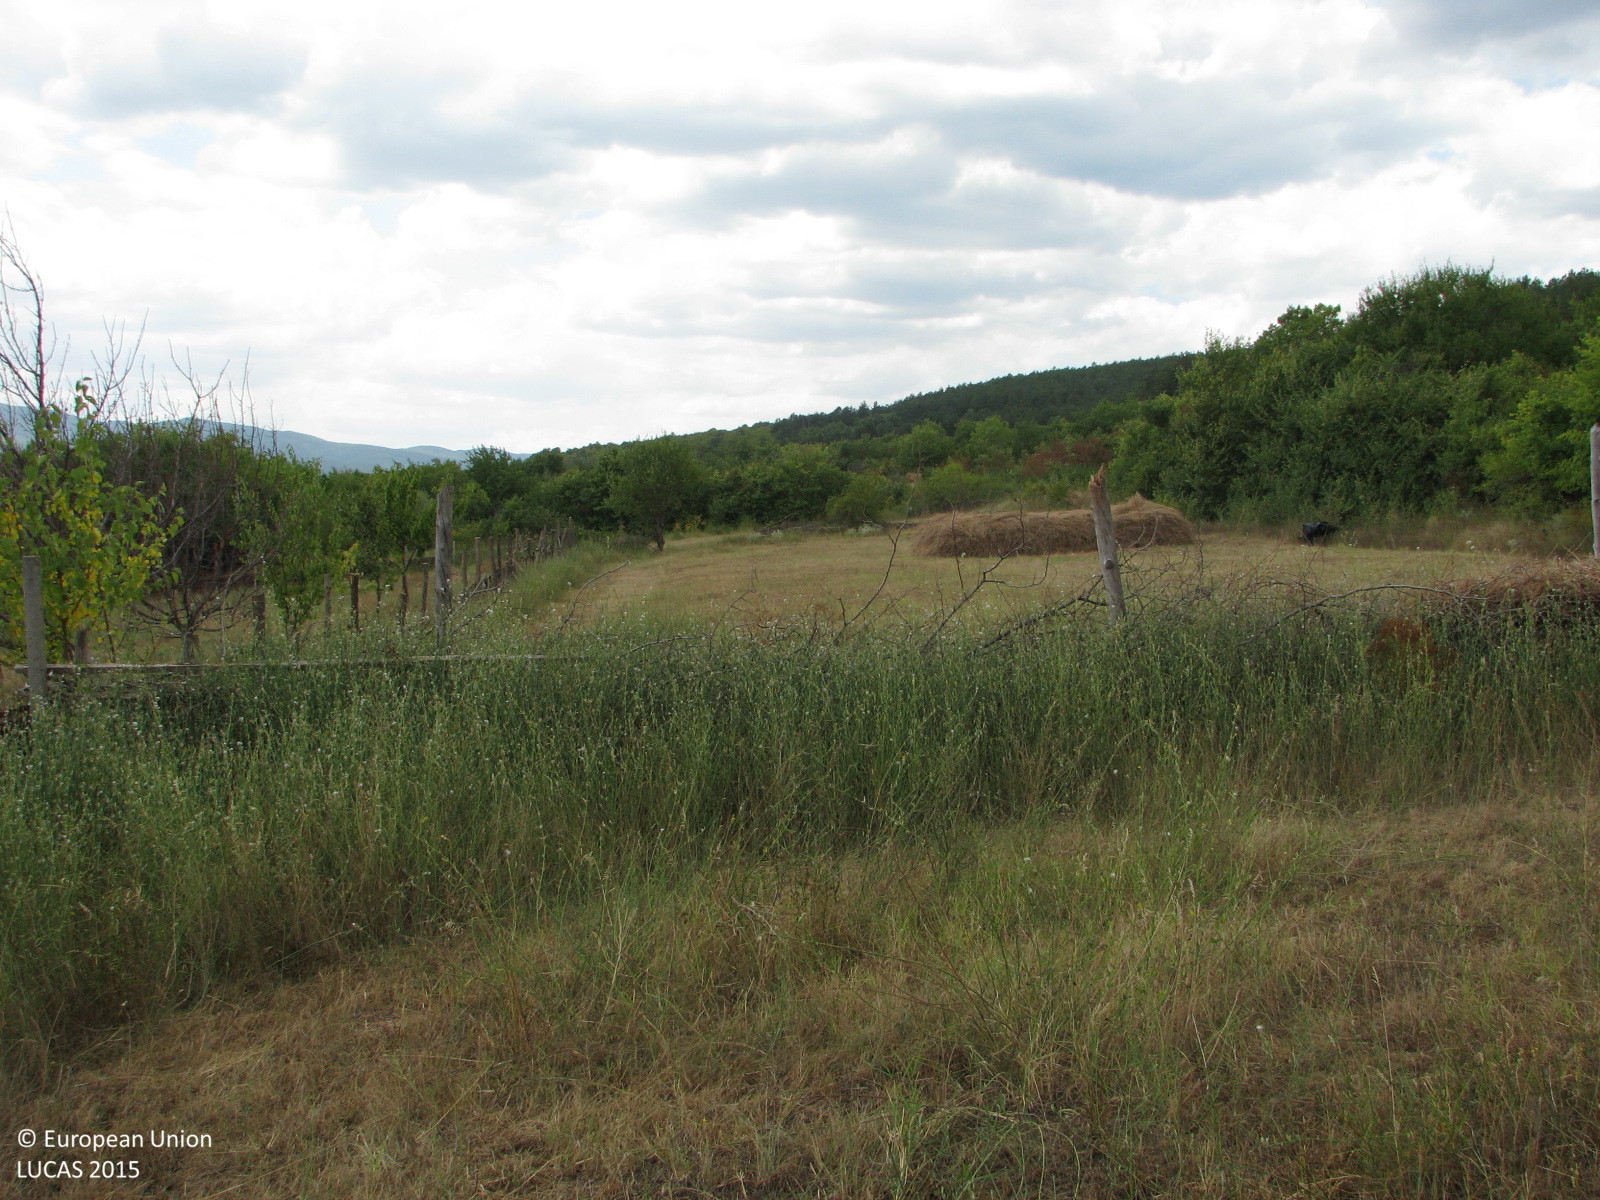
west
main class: Grassland
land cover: Grassland without tree/shrub cover
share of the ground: > 75 %
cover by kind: herbaceous plants 100 %
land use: Agriculture (excluding fallow land and kitchen gardens)
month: August
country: BG
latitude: 42.7404
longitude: 26.6259
